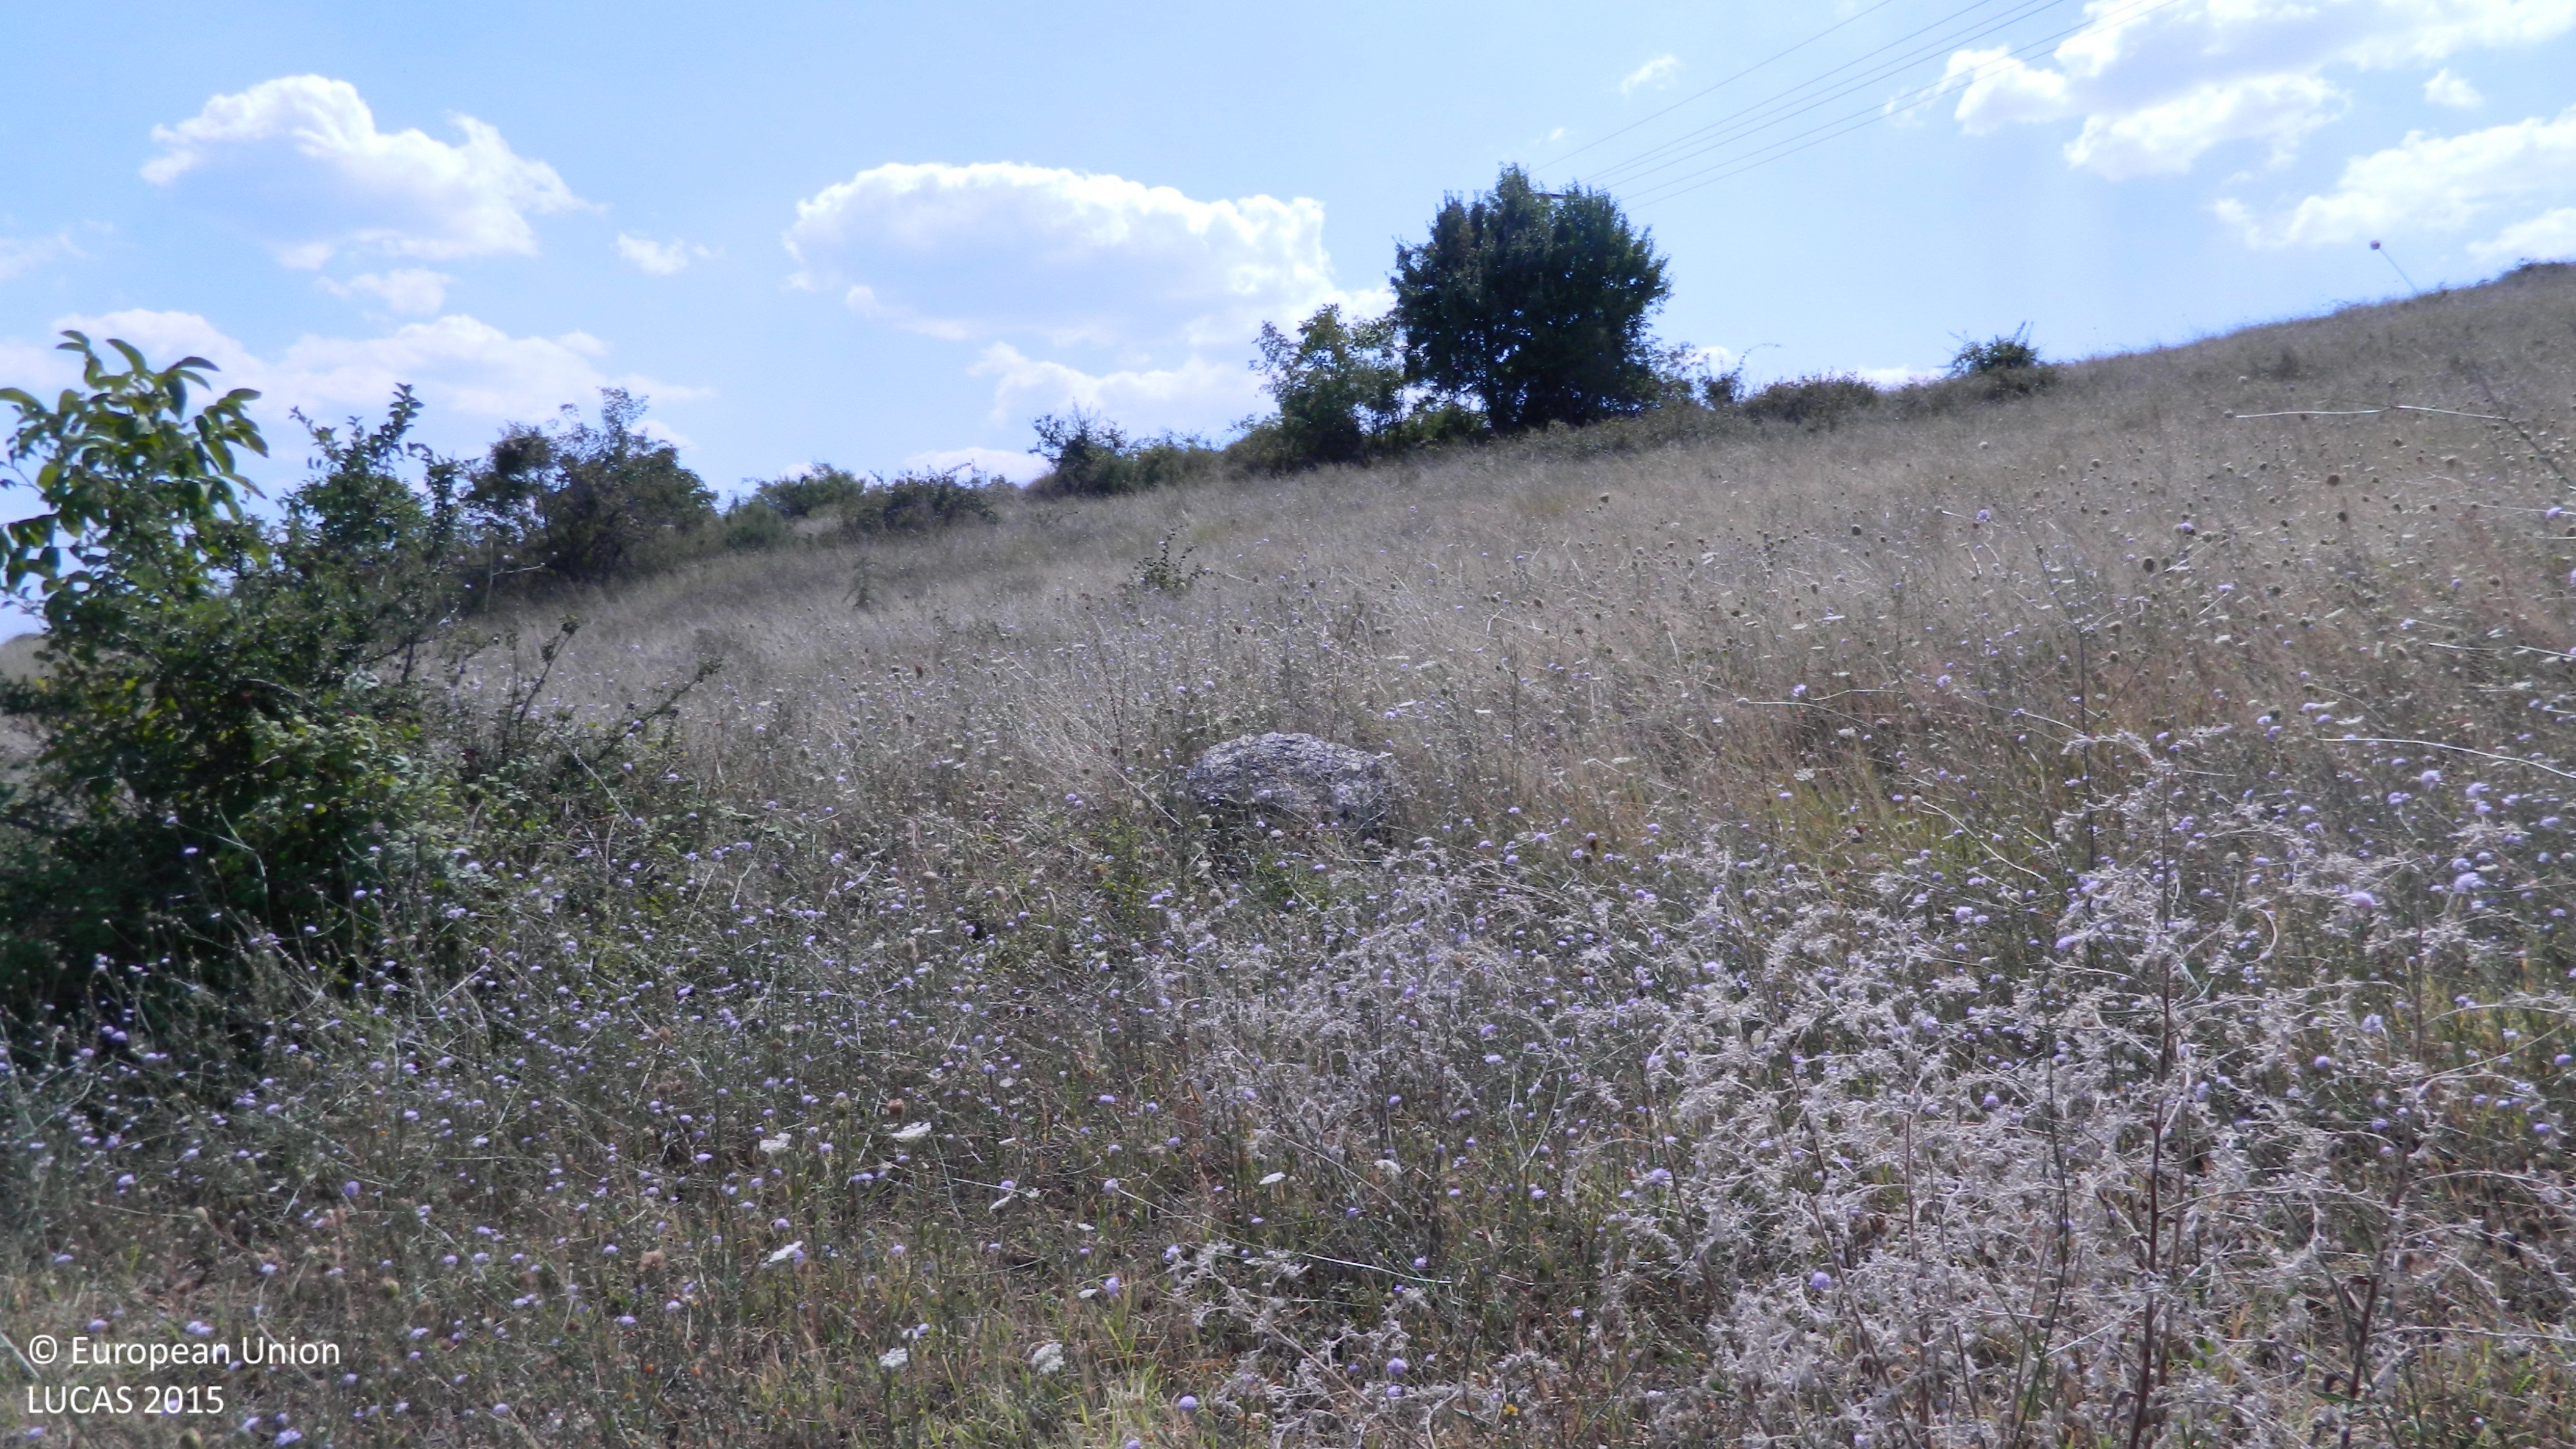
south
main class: Grassland
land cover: Grassland without tree/shrub cover
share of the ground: > 75 %
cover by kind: herbaceous plants 95 %, shrubs 5 %
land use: Agriculture (excluding fallow land and kitchen gardens)
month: August
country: BG
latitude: 41.5190
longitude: 26.1157
